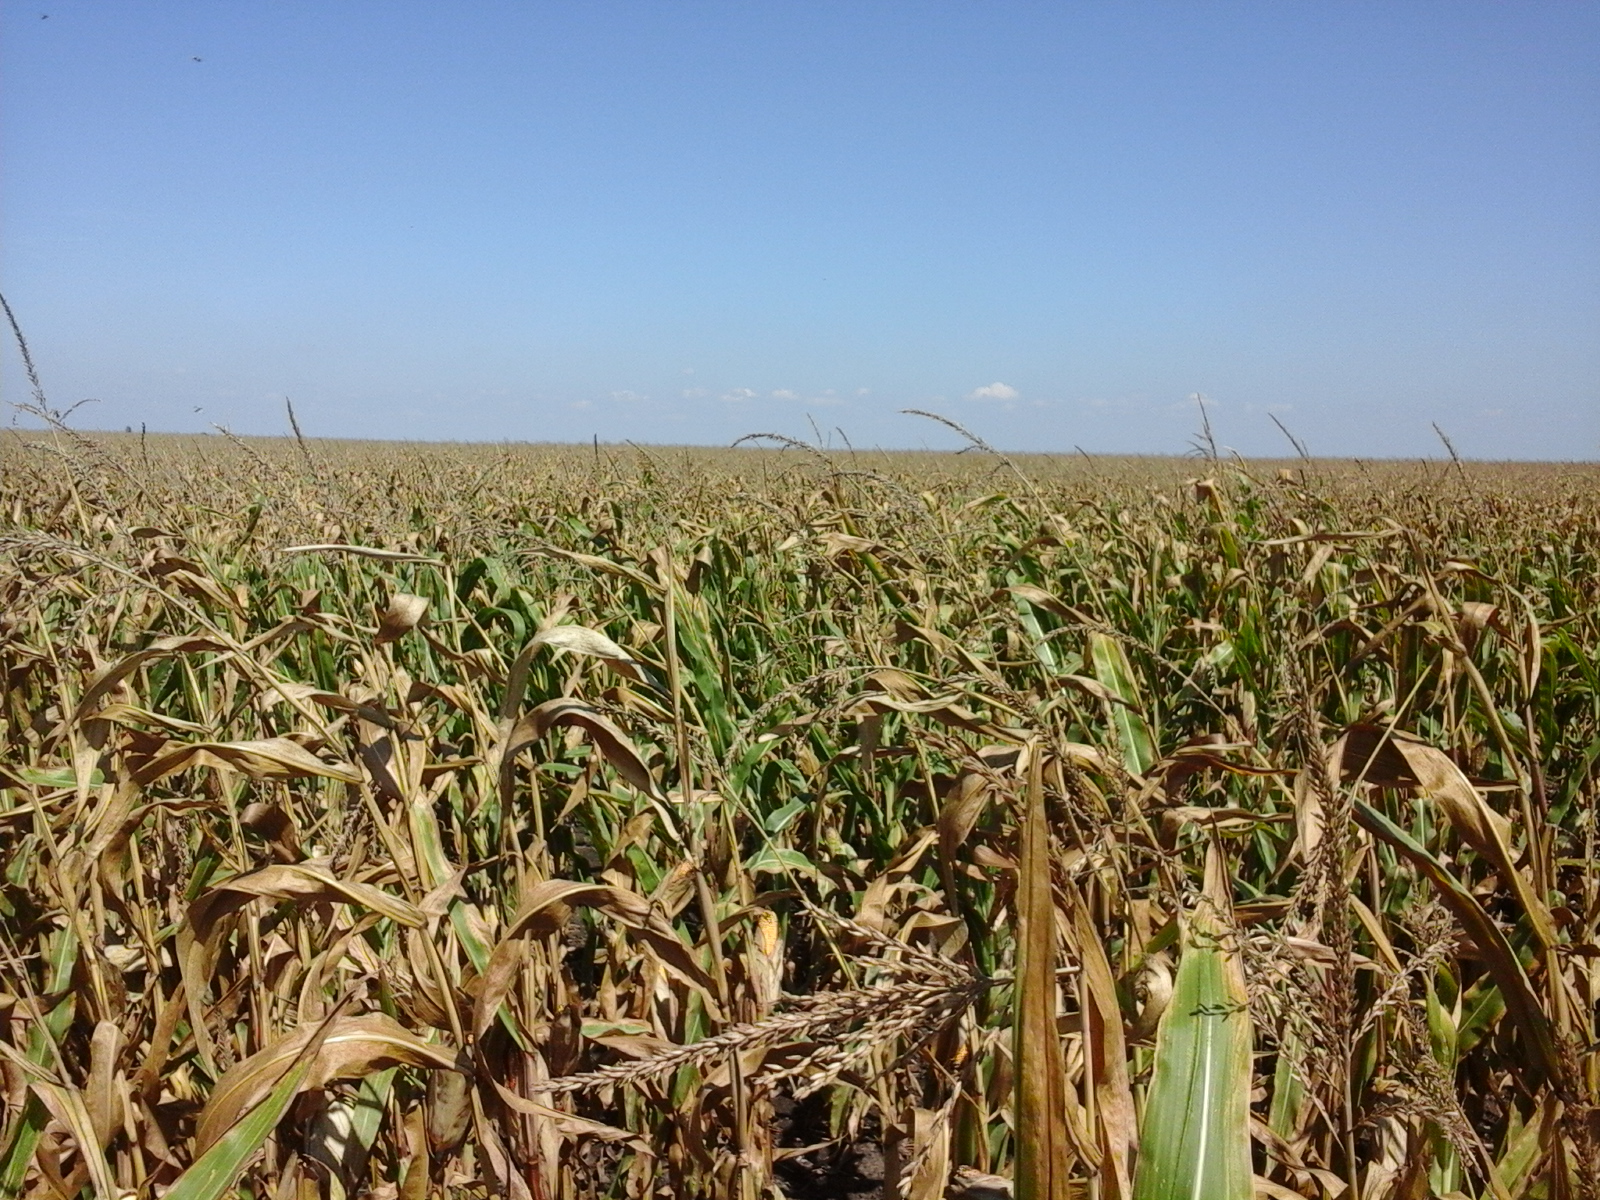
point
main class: Cropland
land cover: Maize
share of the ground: > 75 %
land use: Agriculture (excluding fallow land and kitchen gardens)
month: August
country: RO
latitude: 45.8052
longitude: 20.9522
